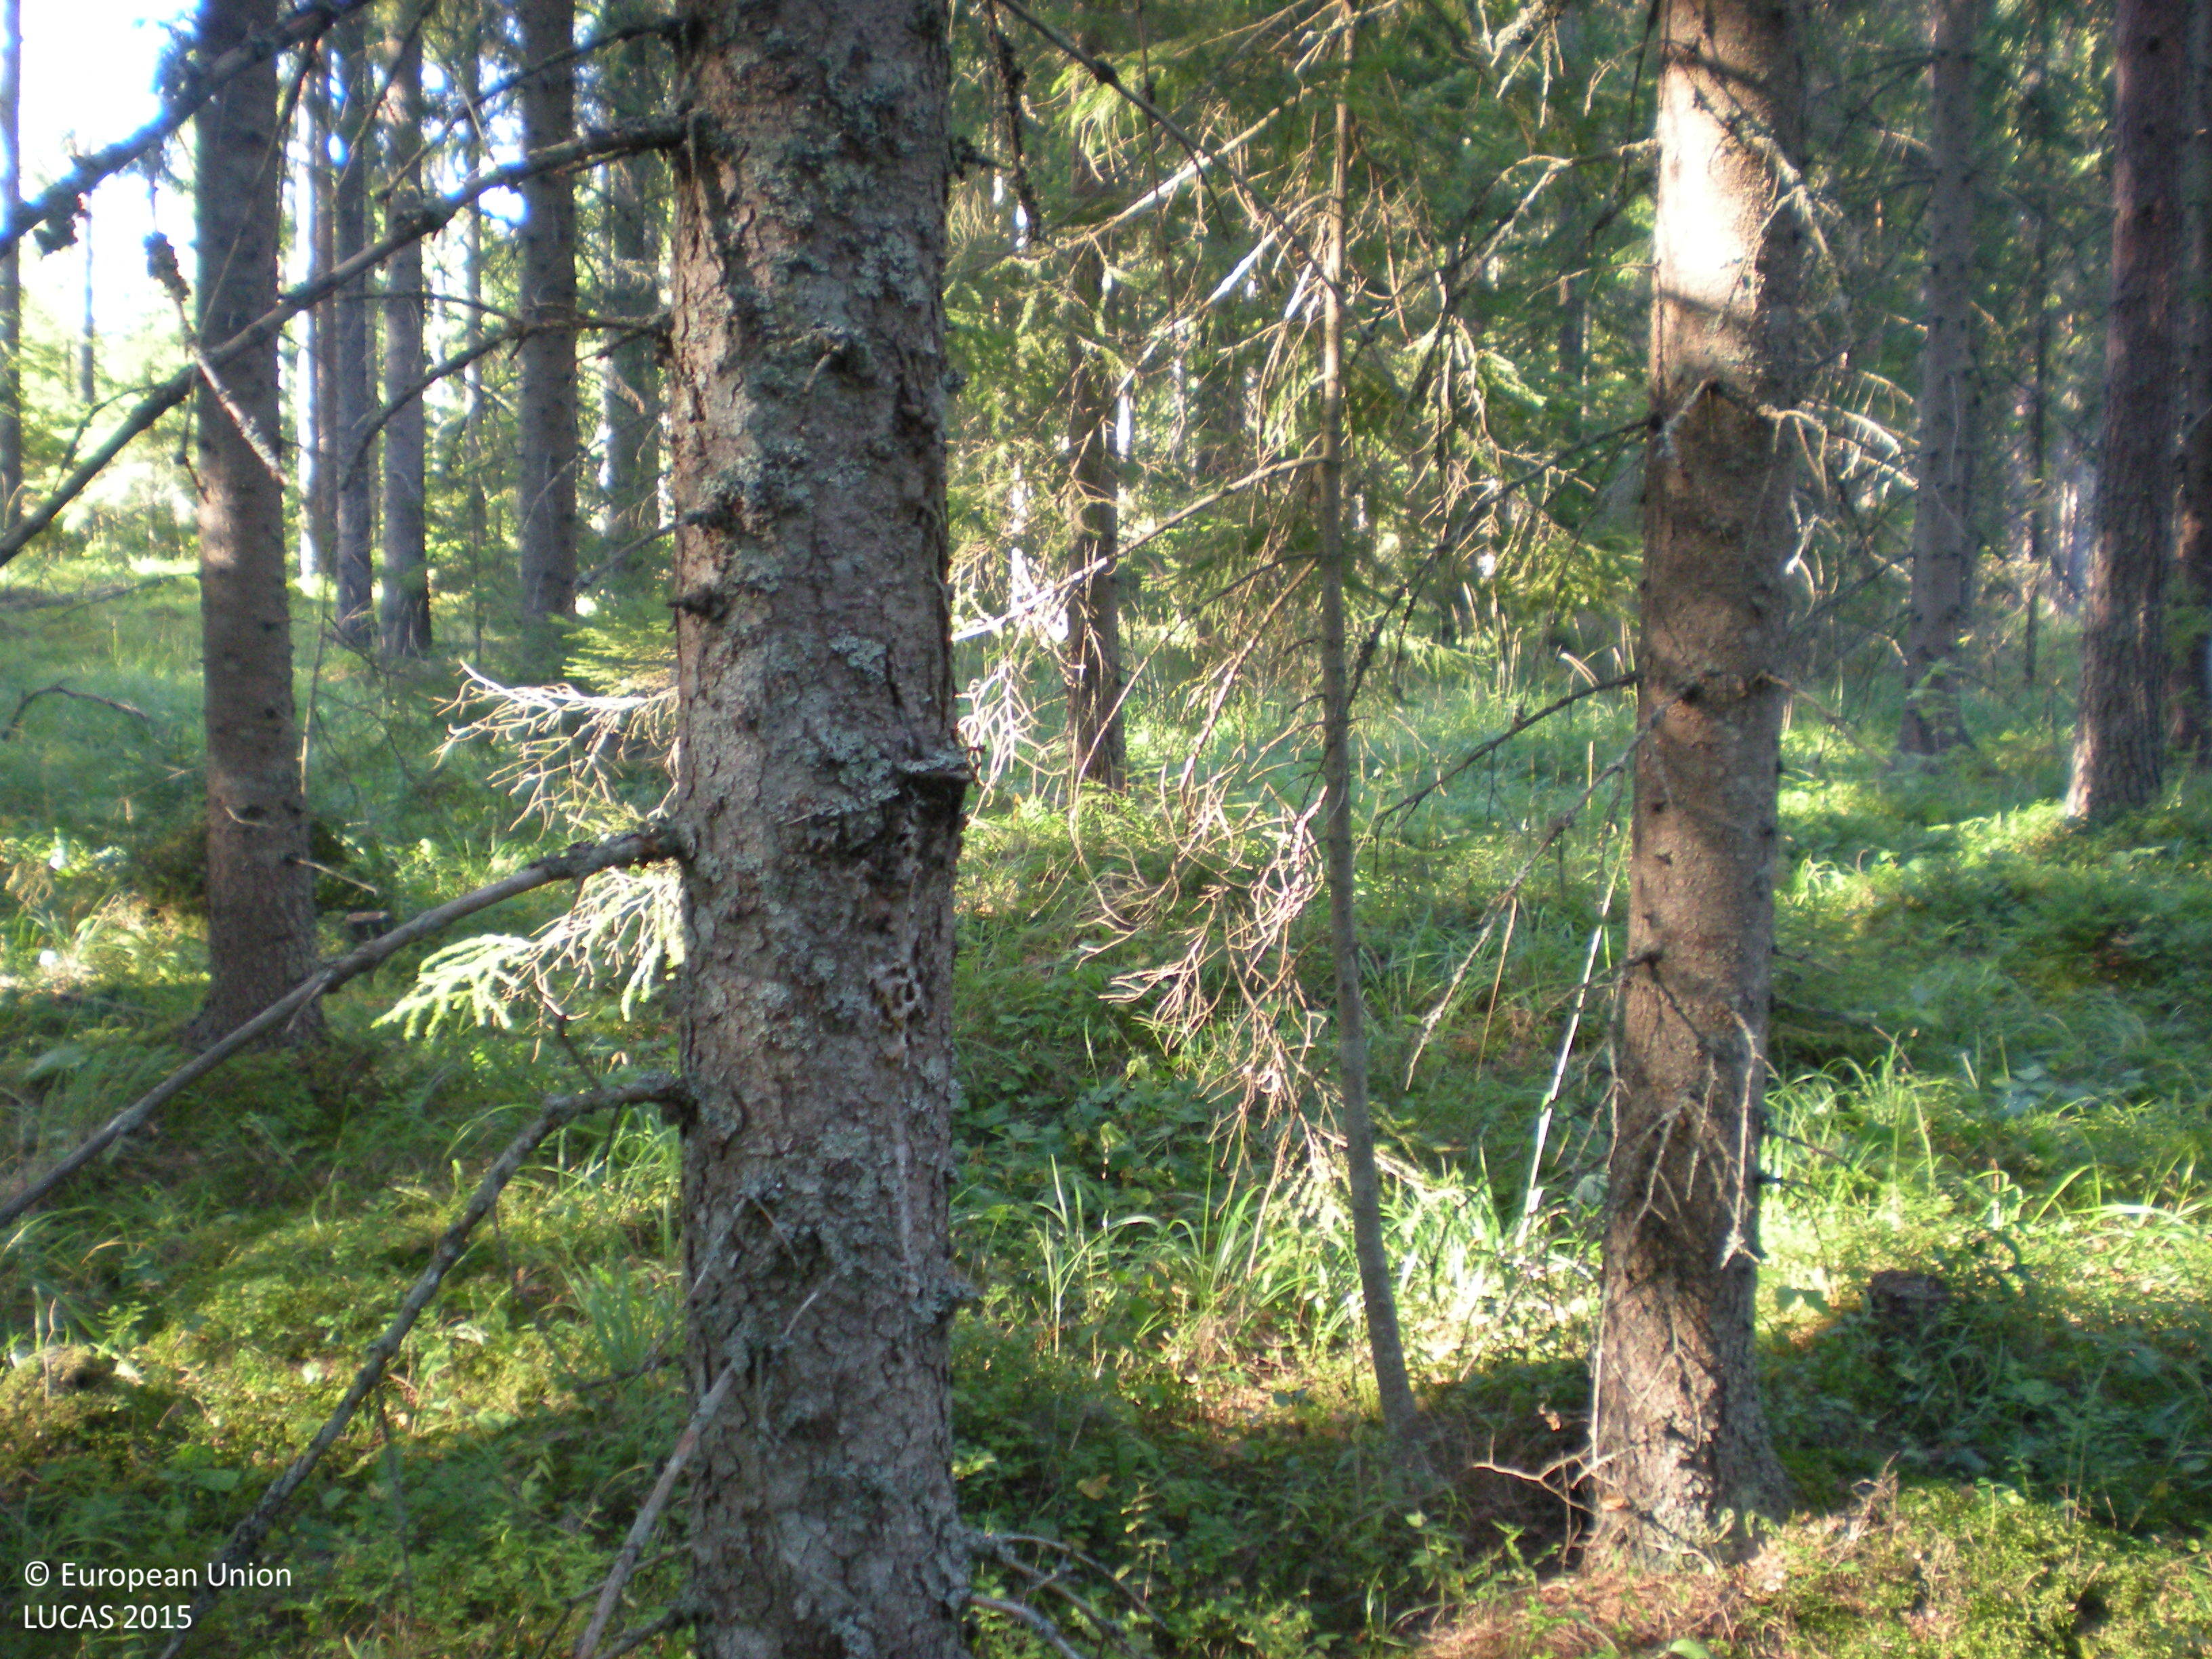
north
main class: Woodland
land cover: Spruce dominated coniferous woodland
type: boreal forest
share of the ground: 50 - 75 %
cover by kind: coniferous forest trees 70 %, herbaceous plants 10 %, lichens and mosses 10 %, broadleaved forest trees 5 %, shrubs 5 %
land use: Forestry
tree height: > 5 m
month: August
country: SE
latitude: 60.5701
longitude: 17.3062
